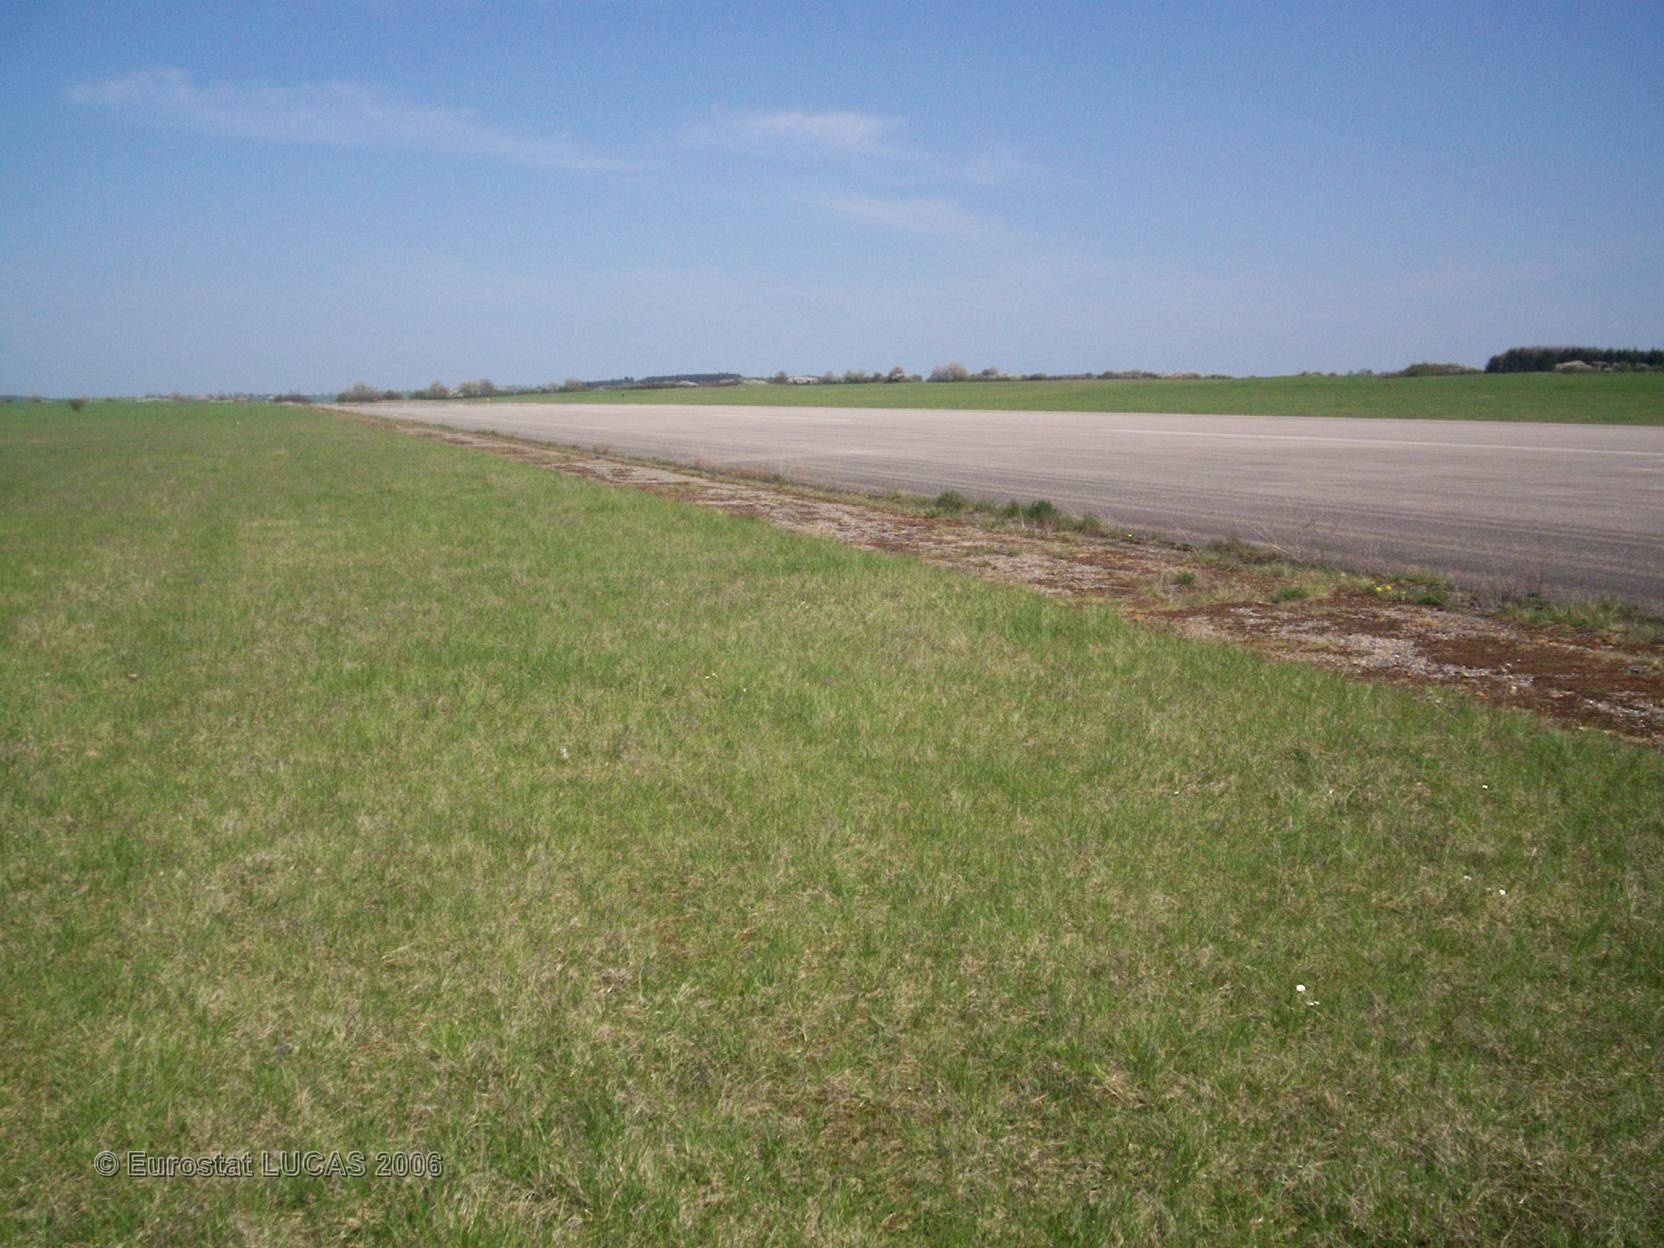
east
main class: Grassland
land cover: Grassland without tree/shrub cover
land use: Amenities, museums, leisure
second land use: Air transport
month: April
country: FR
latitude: 49.0294
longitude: 5.8827
